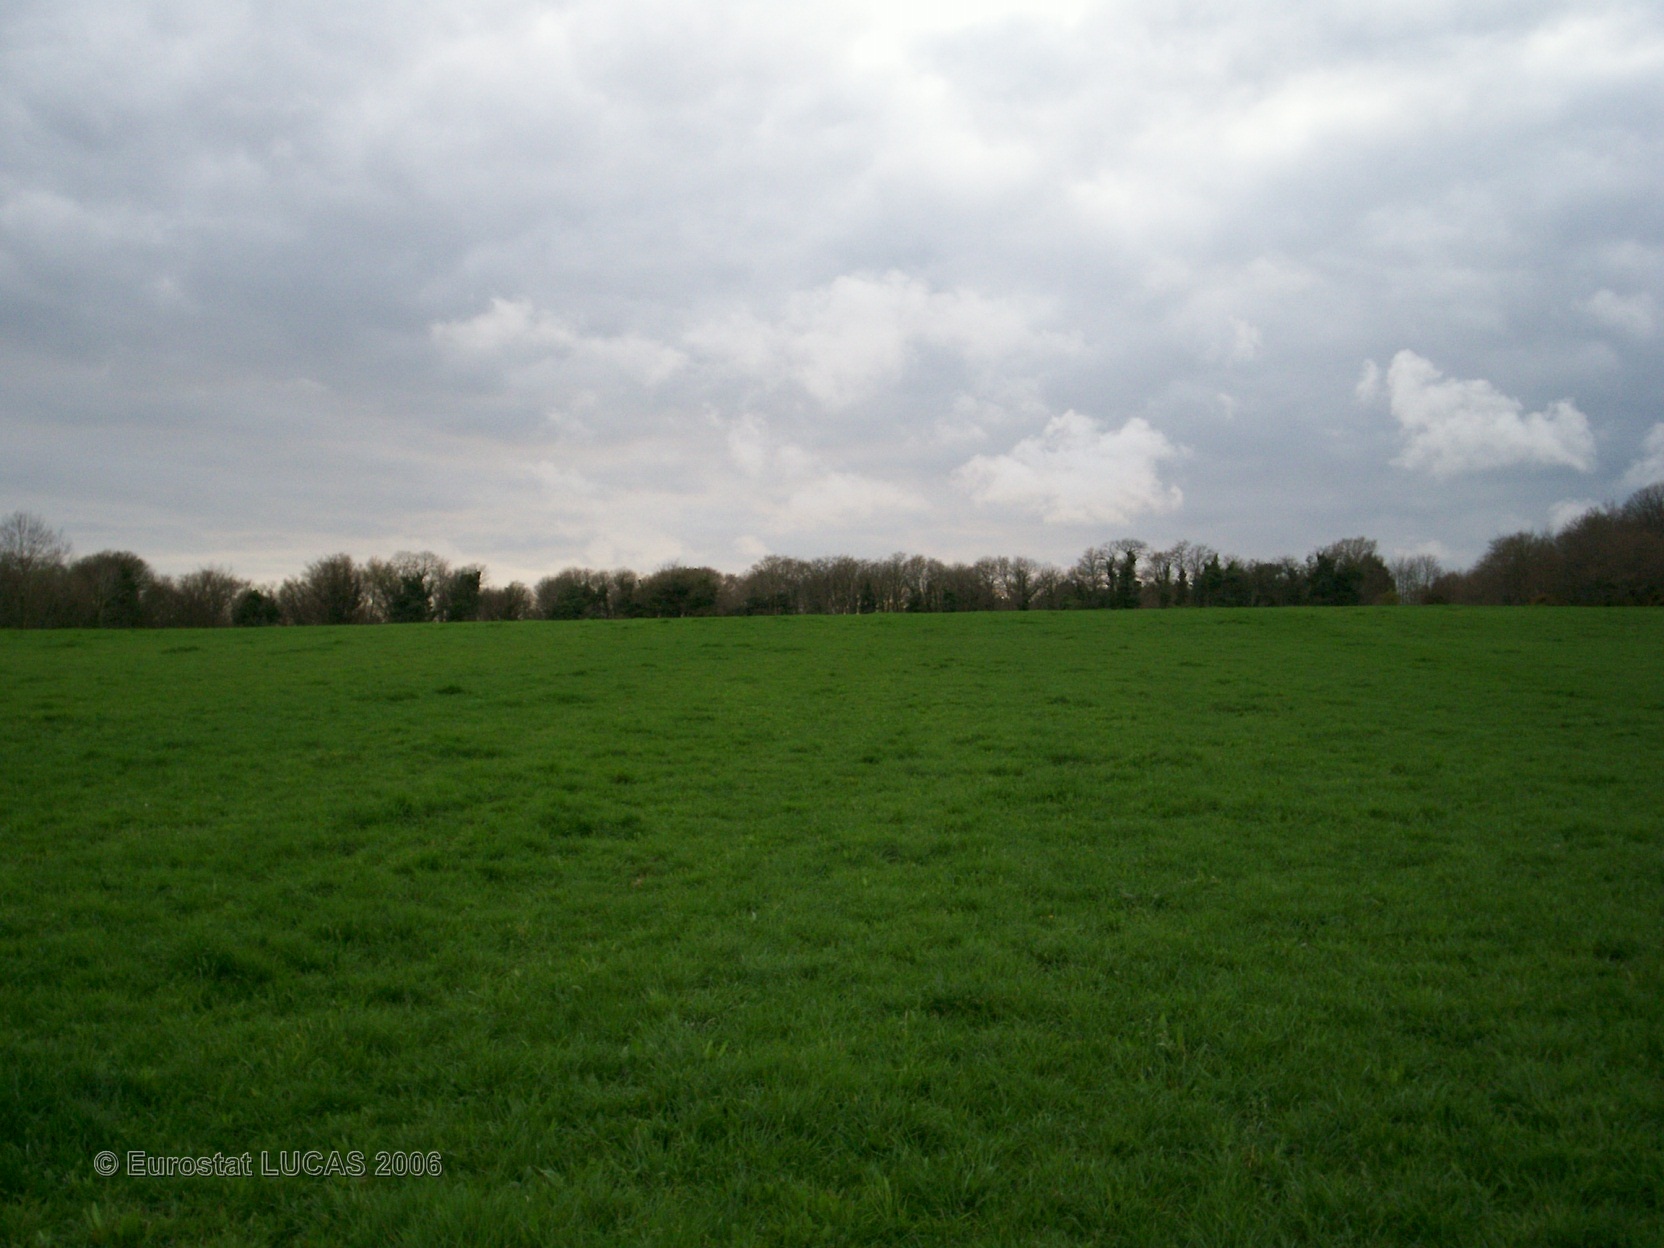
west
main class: Grassland
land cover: Grassland without tree/shrub cover
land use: Agriculture (excluding fallow land and kitchen gardens)
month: April
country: FR
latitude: 47.8085
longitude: -3.4957
